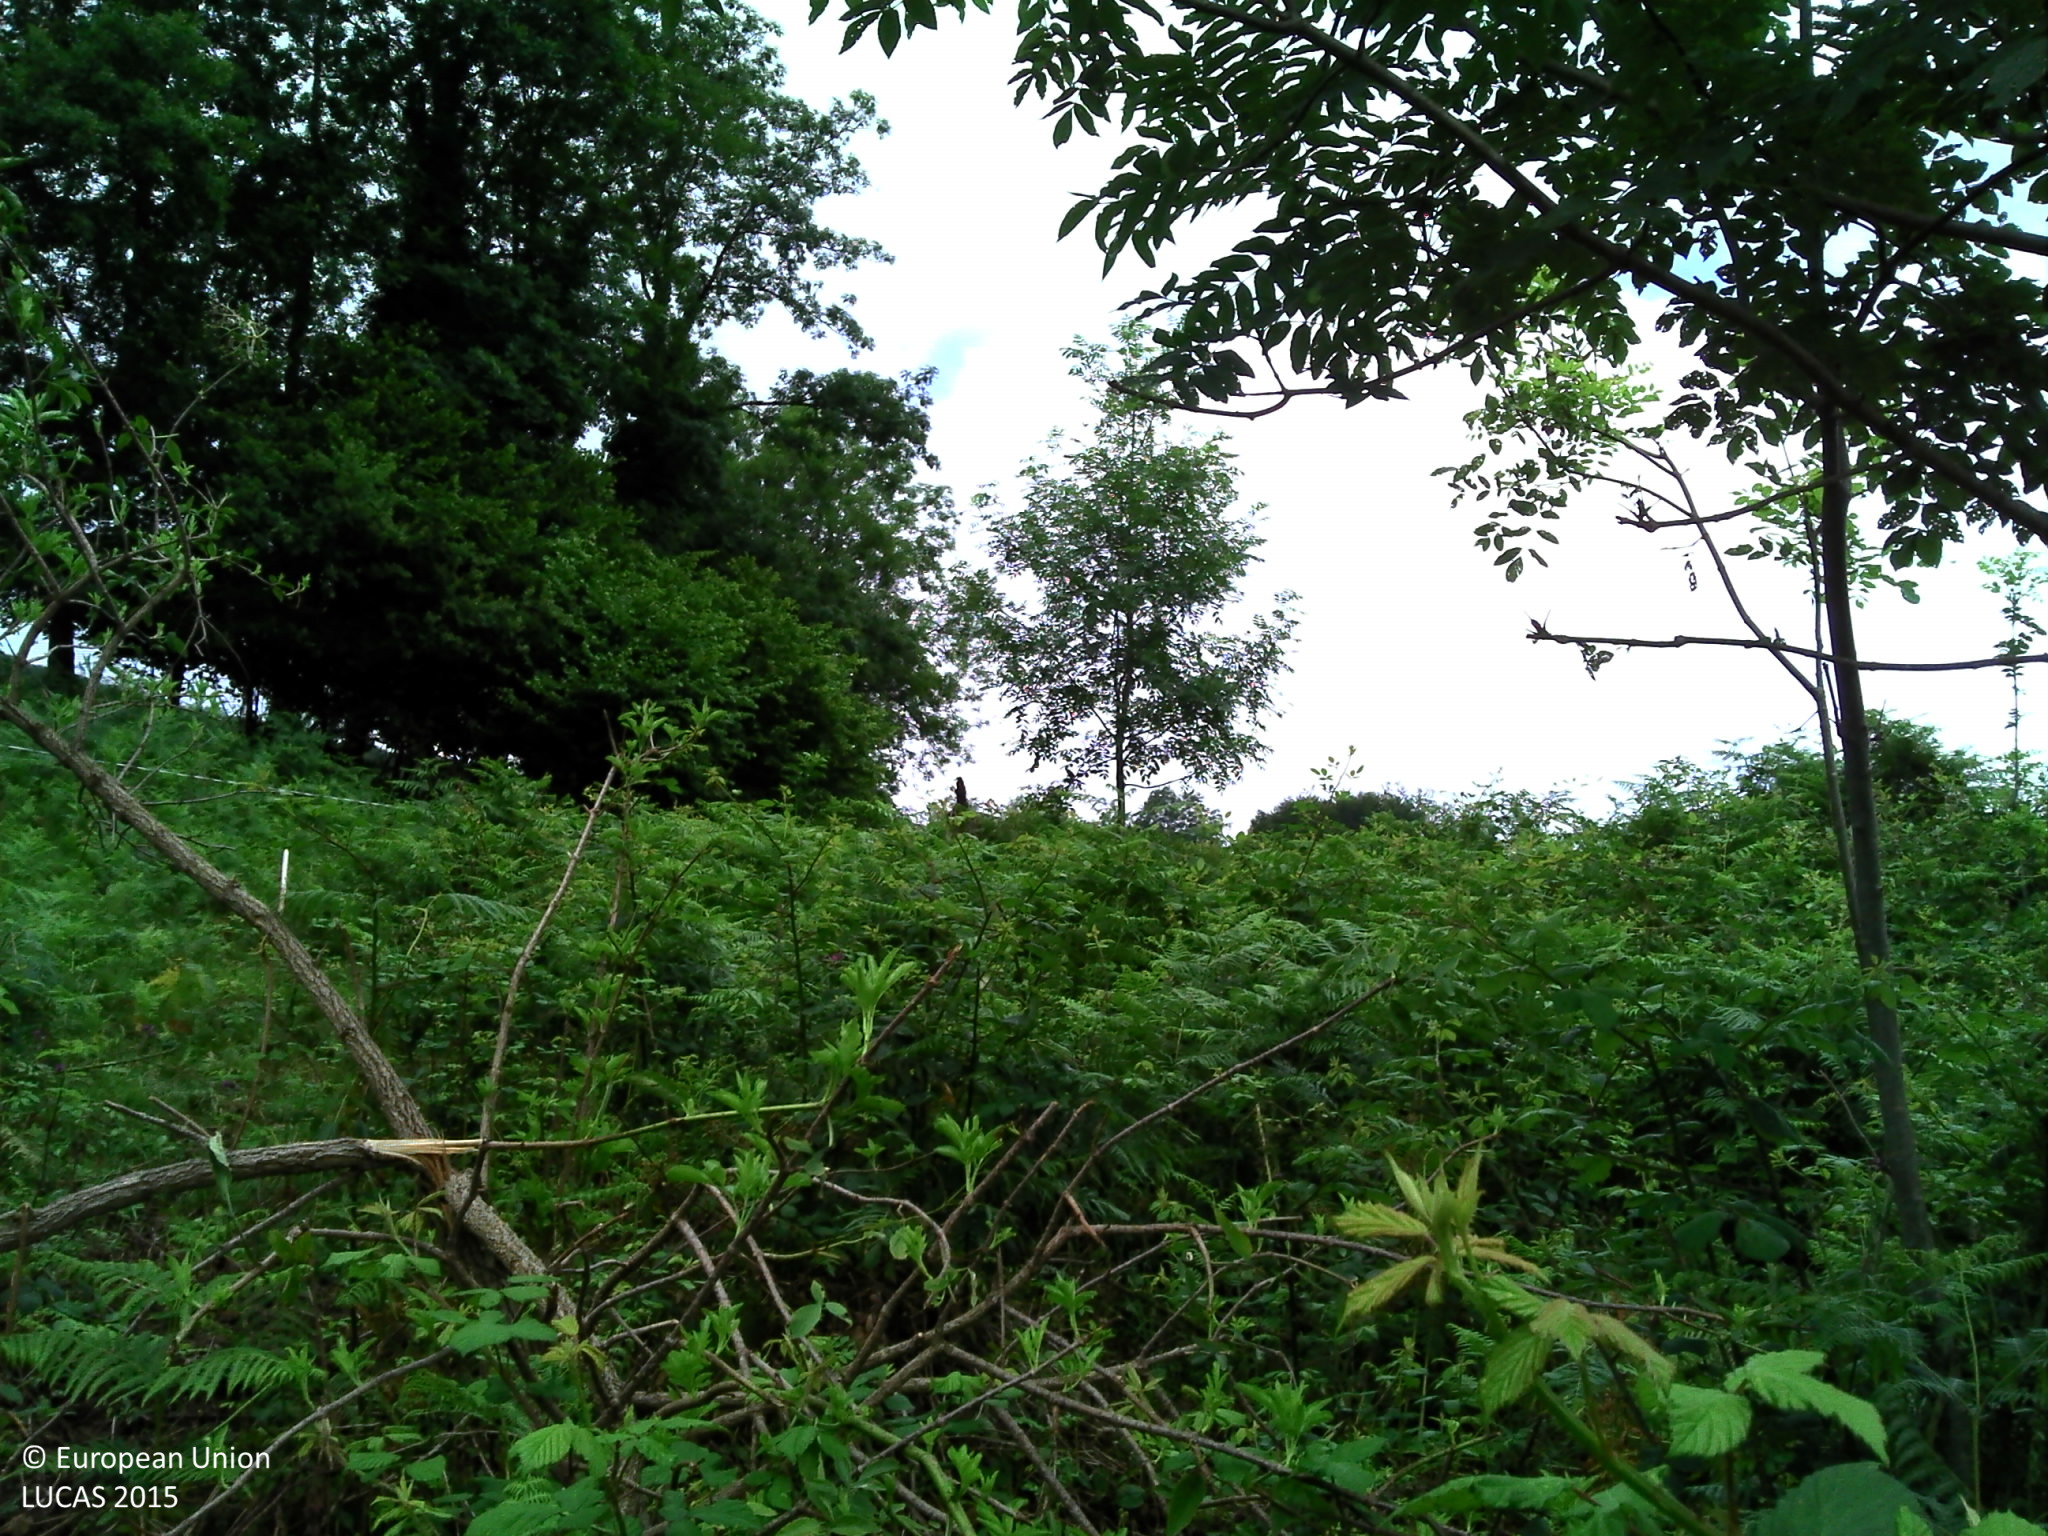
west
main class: Grassland
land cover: Grassland with sparse tree/shrub cover
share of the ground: > 75 %
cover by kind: herbaceous plants 90 %, broadleaved forest trees 5 %, shrubs 5 %
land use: Agriculture (excluding fallow land and kitchen gardens)
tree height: > 5 m
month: July
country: FR
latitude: 42.8835
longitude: 1.1533
